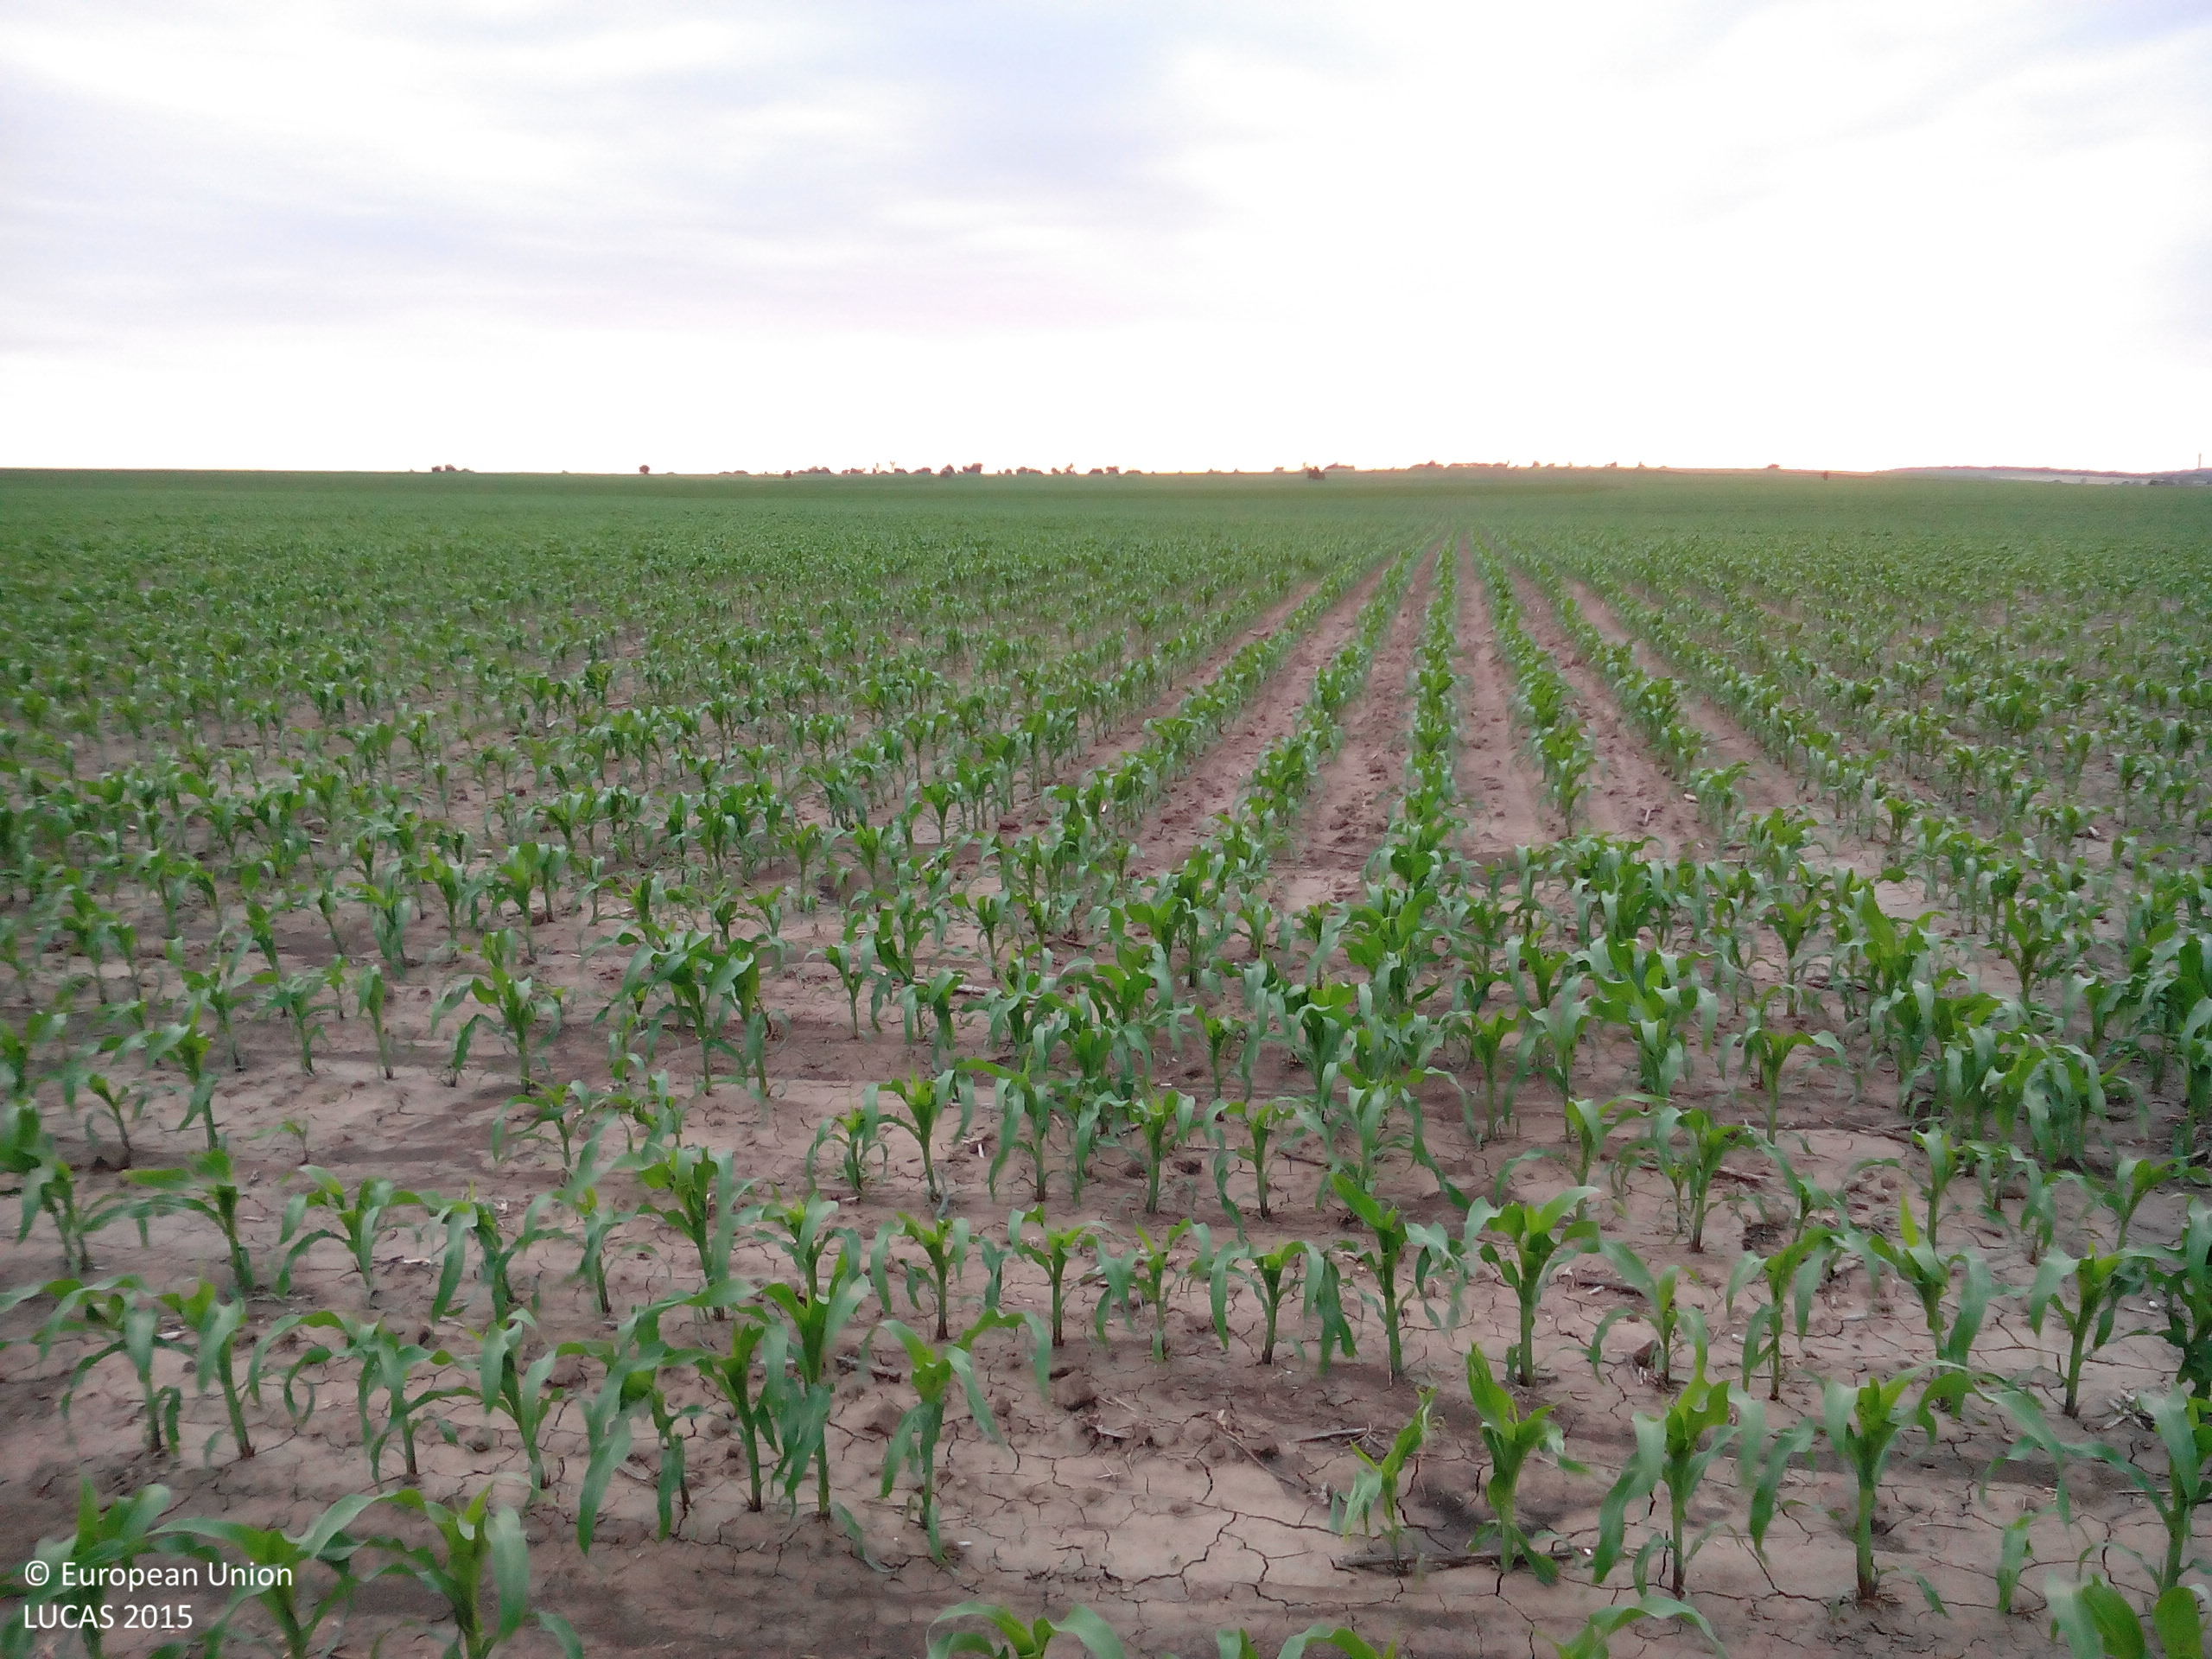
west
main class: Cropland
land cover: Maize
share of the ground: 25 - 50 %
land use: Agriculture (excluding fallow land and kitchen gardens)
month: May
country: BG
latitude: 43.5287
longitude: 24.0985
